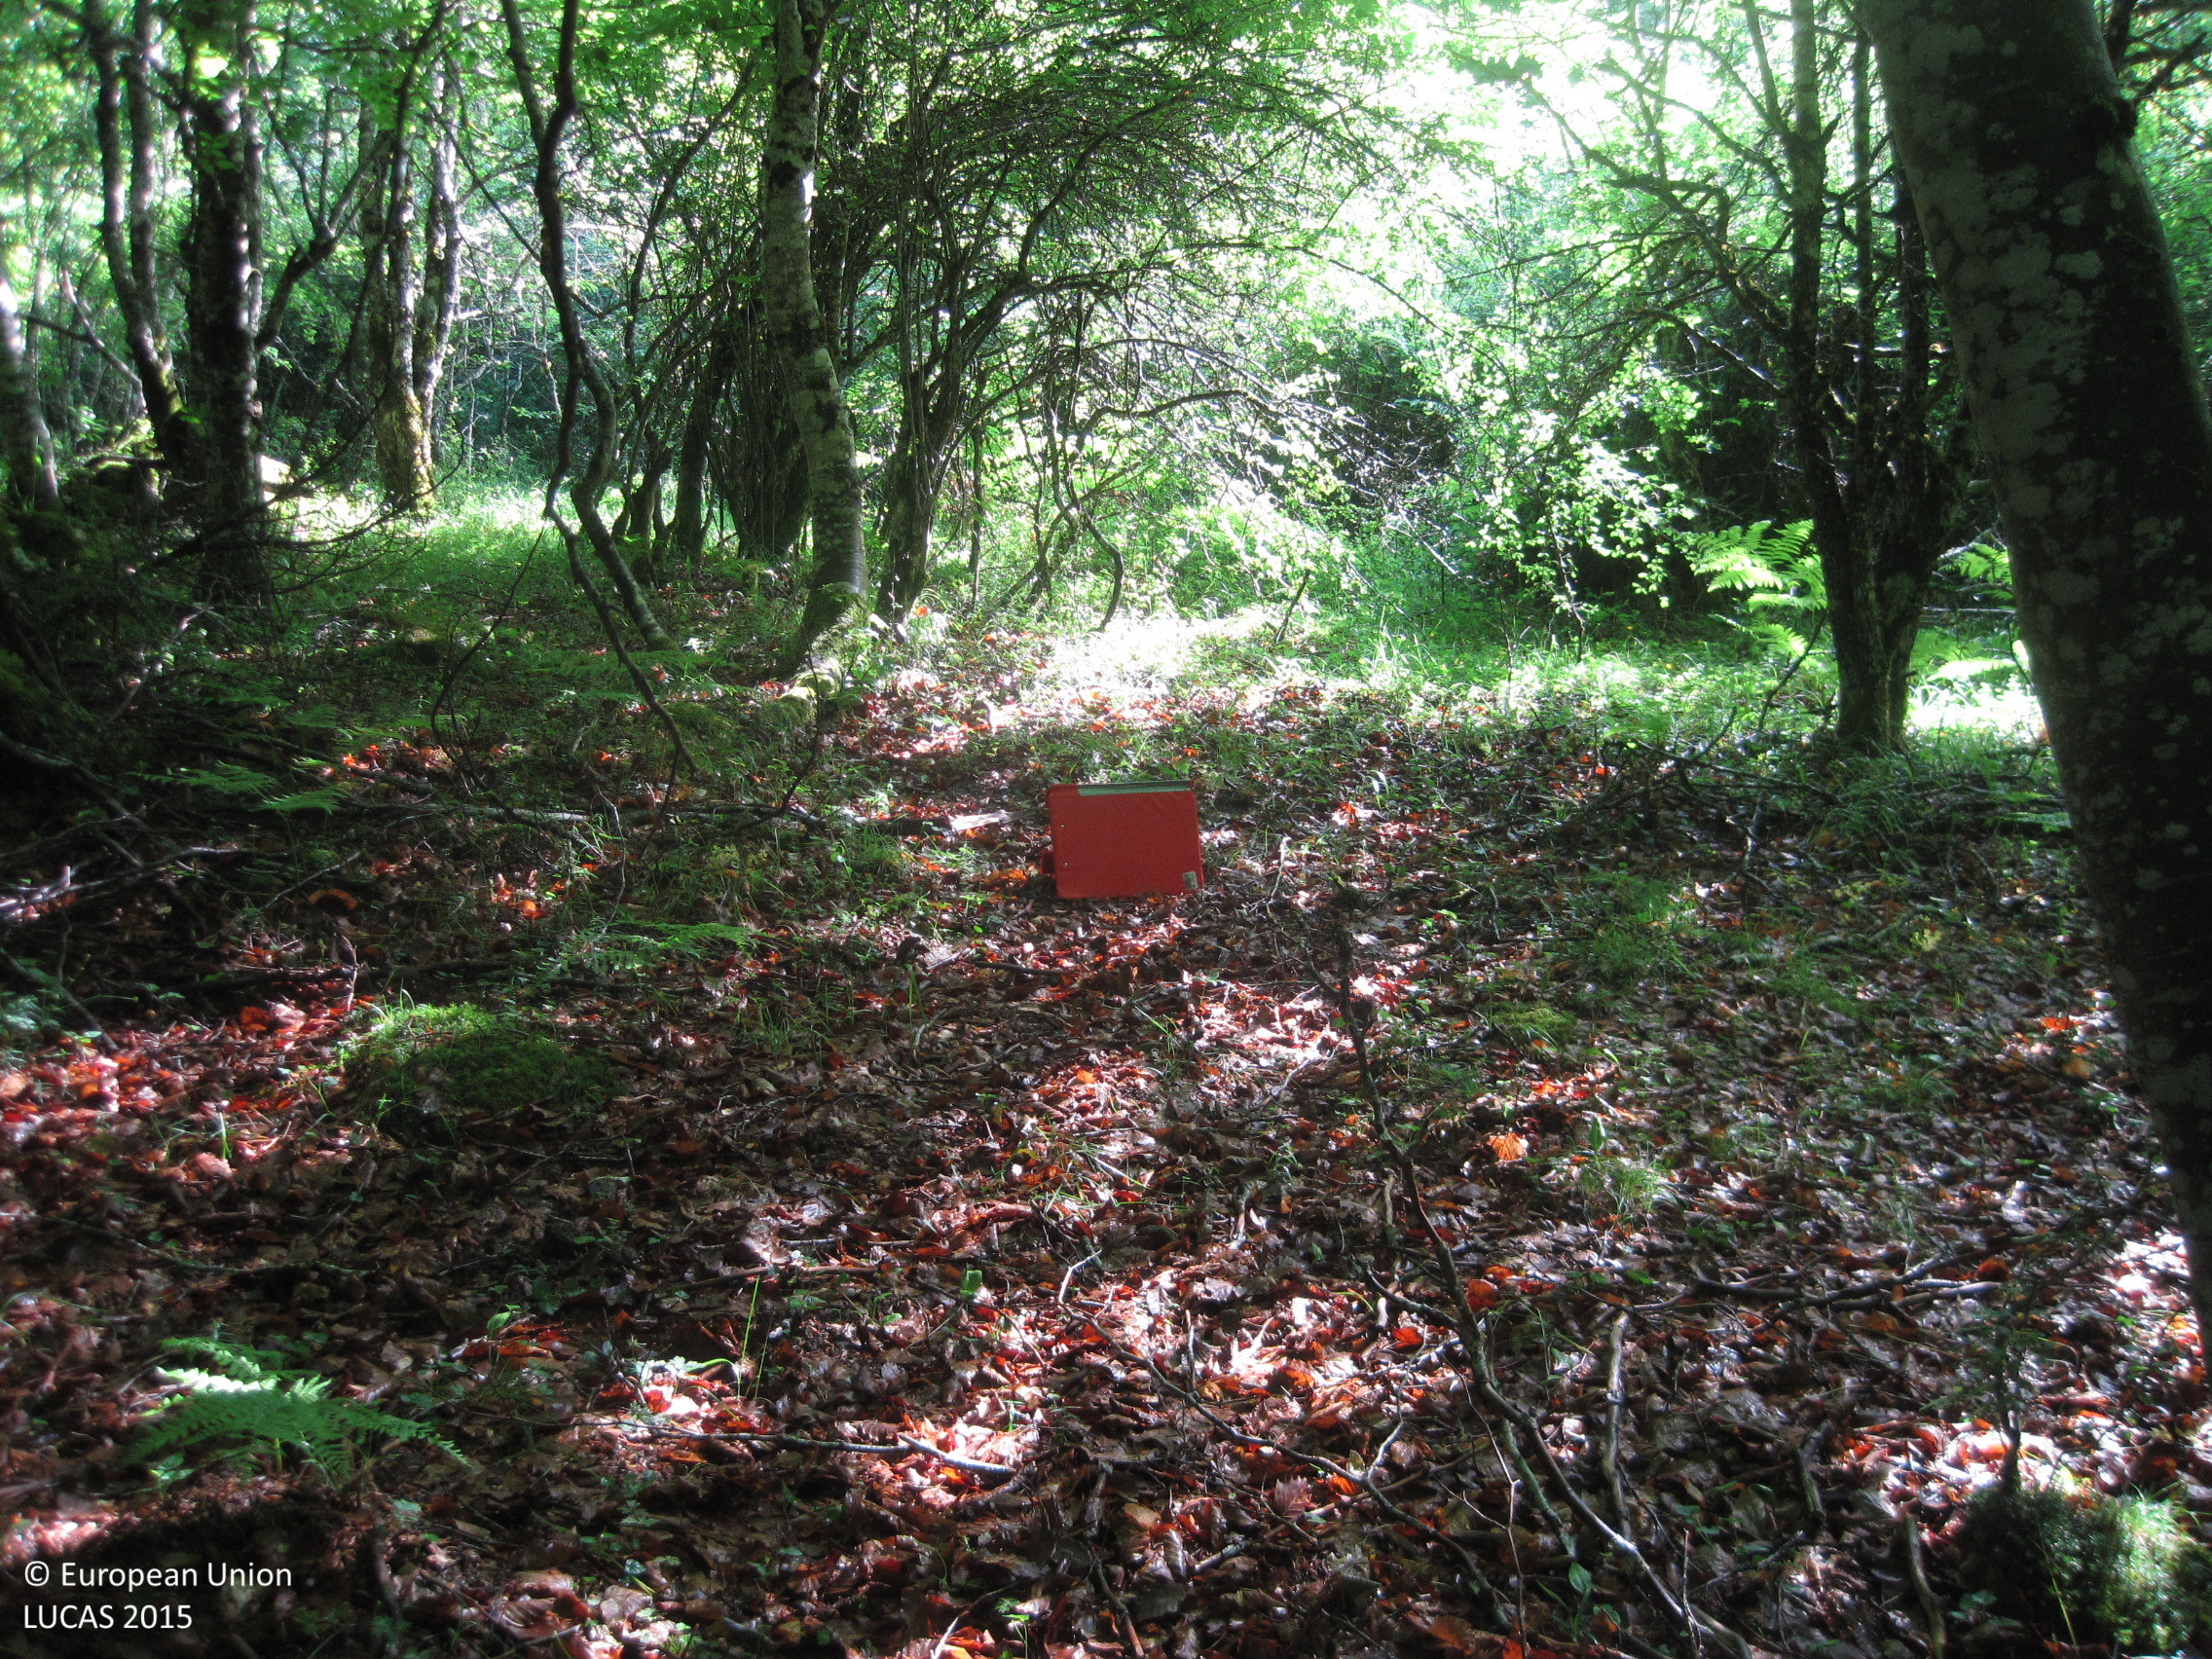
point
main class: Woodland
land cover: Broadleaved woodland
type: acidophilous oak and oak-birch forest
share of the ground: > 75 %
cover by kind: broadleaved forest trees 100 %
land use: Forestry
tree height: > 5 m
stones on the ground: < 10 %
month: June
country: ES
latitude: 42.8088
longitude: -2.1883
